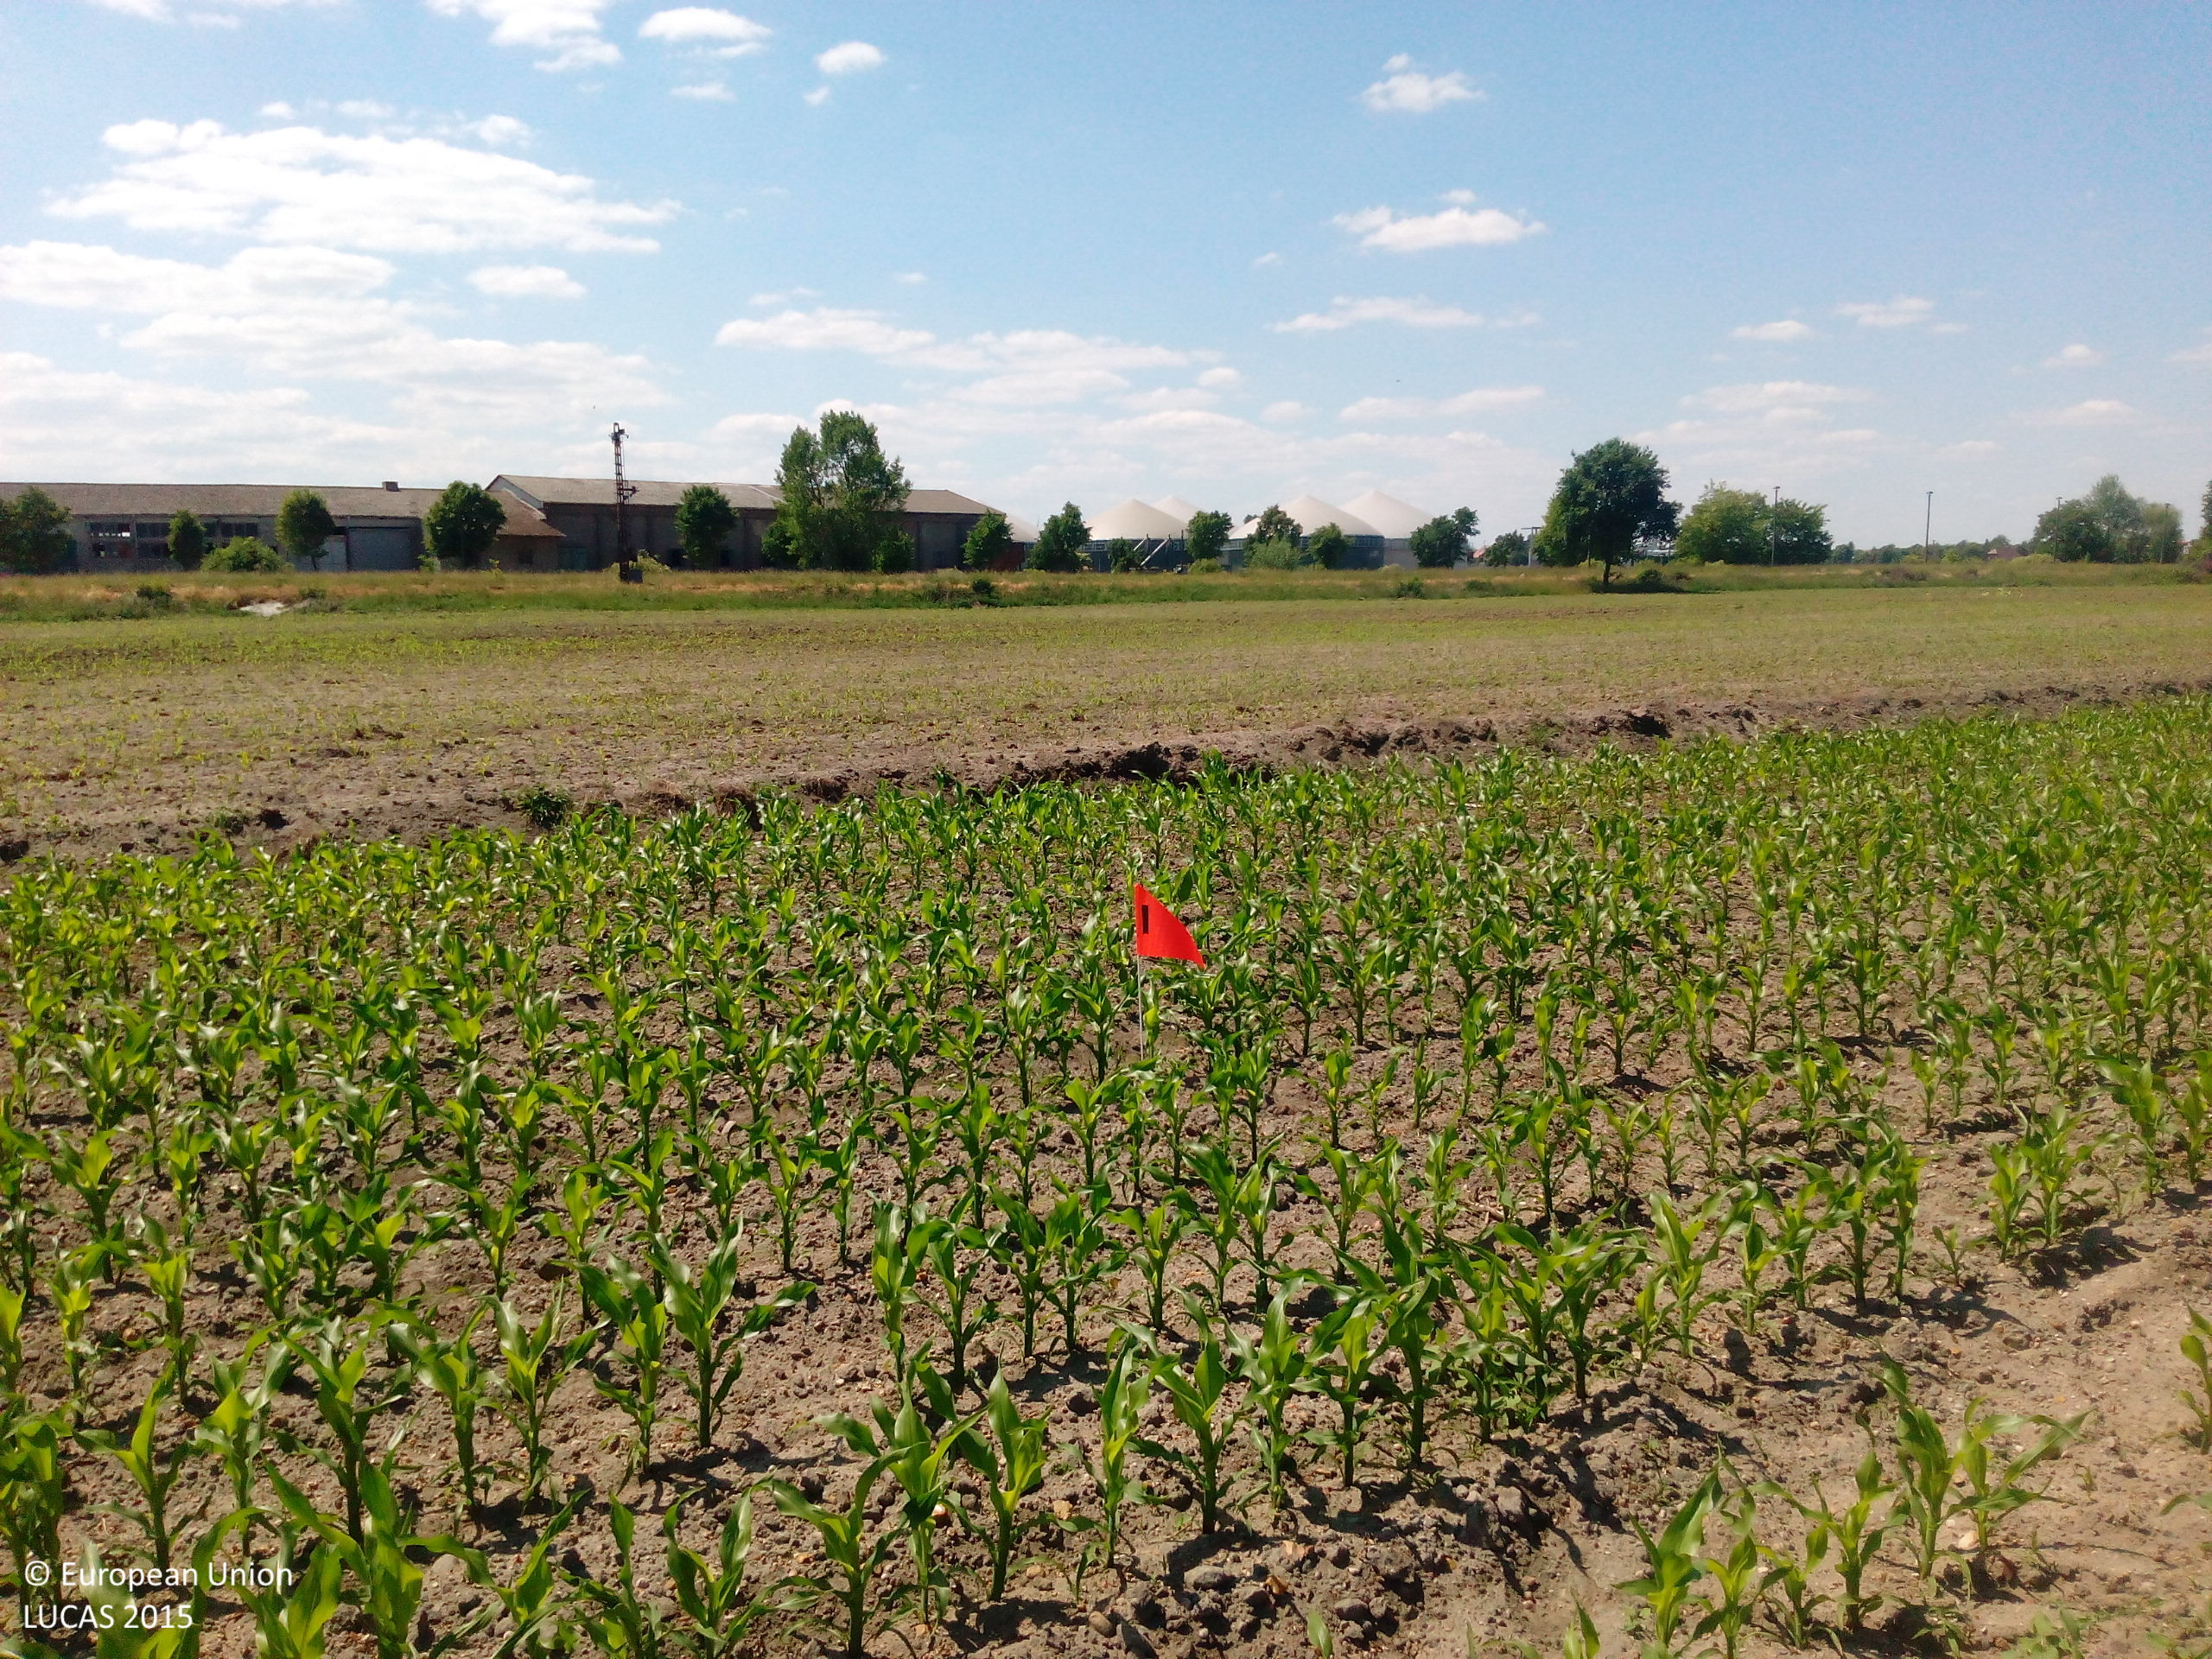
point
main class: Cropland
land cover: Maize
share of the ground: 10 - 25 %
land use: Agriculture (excluding fallow land and kitchen gardens)
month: June
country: DE
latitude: 52.4080
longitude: 11.1315
